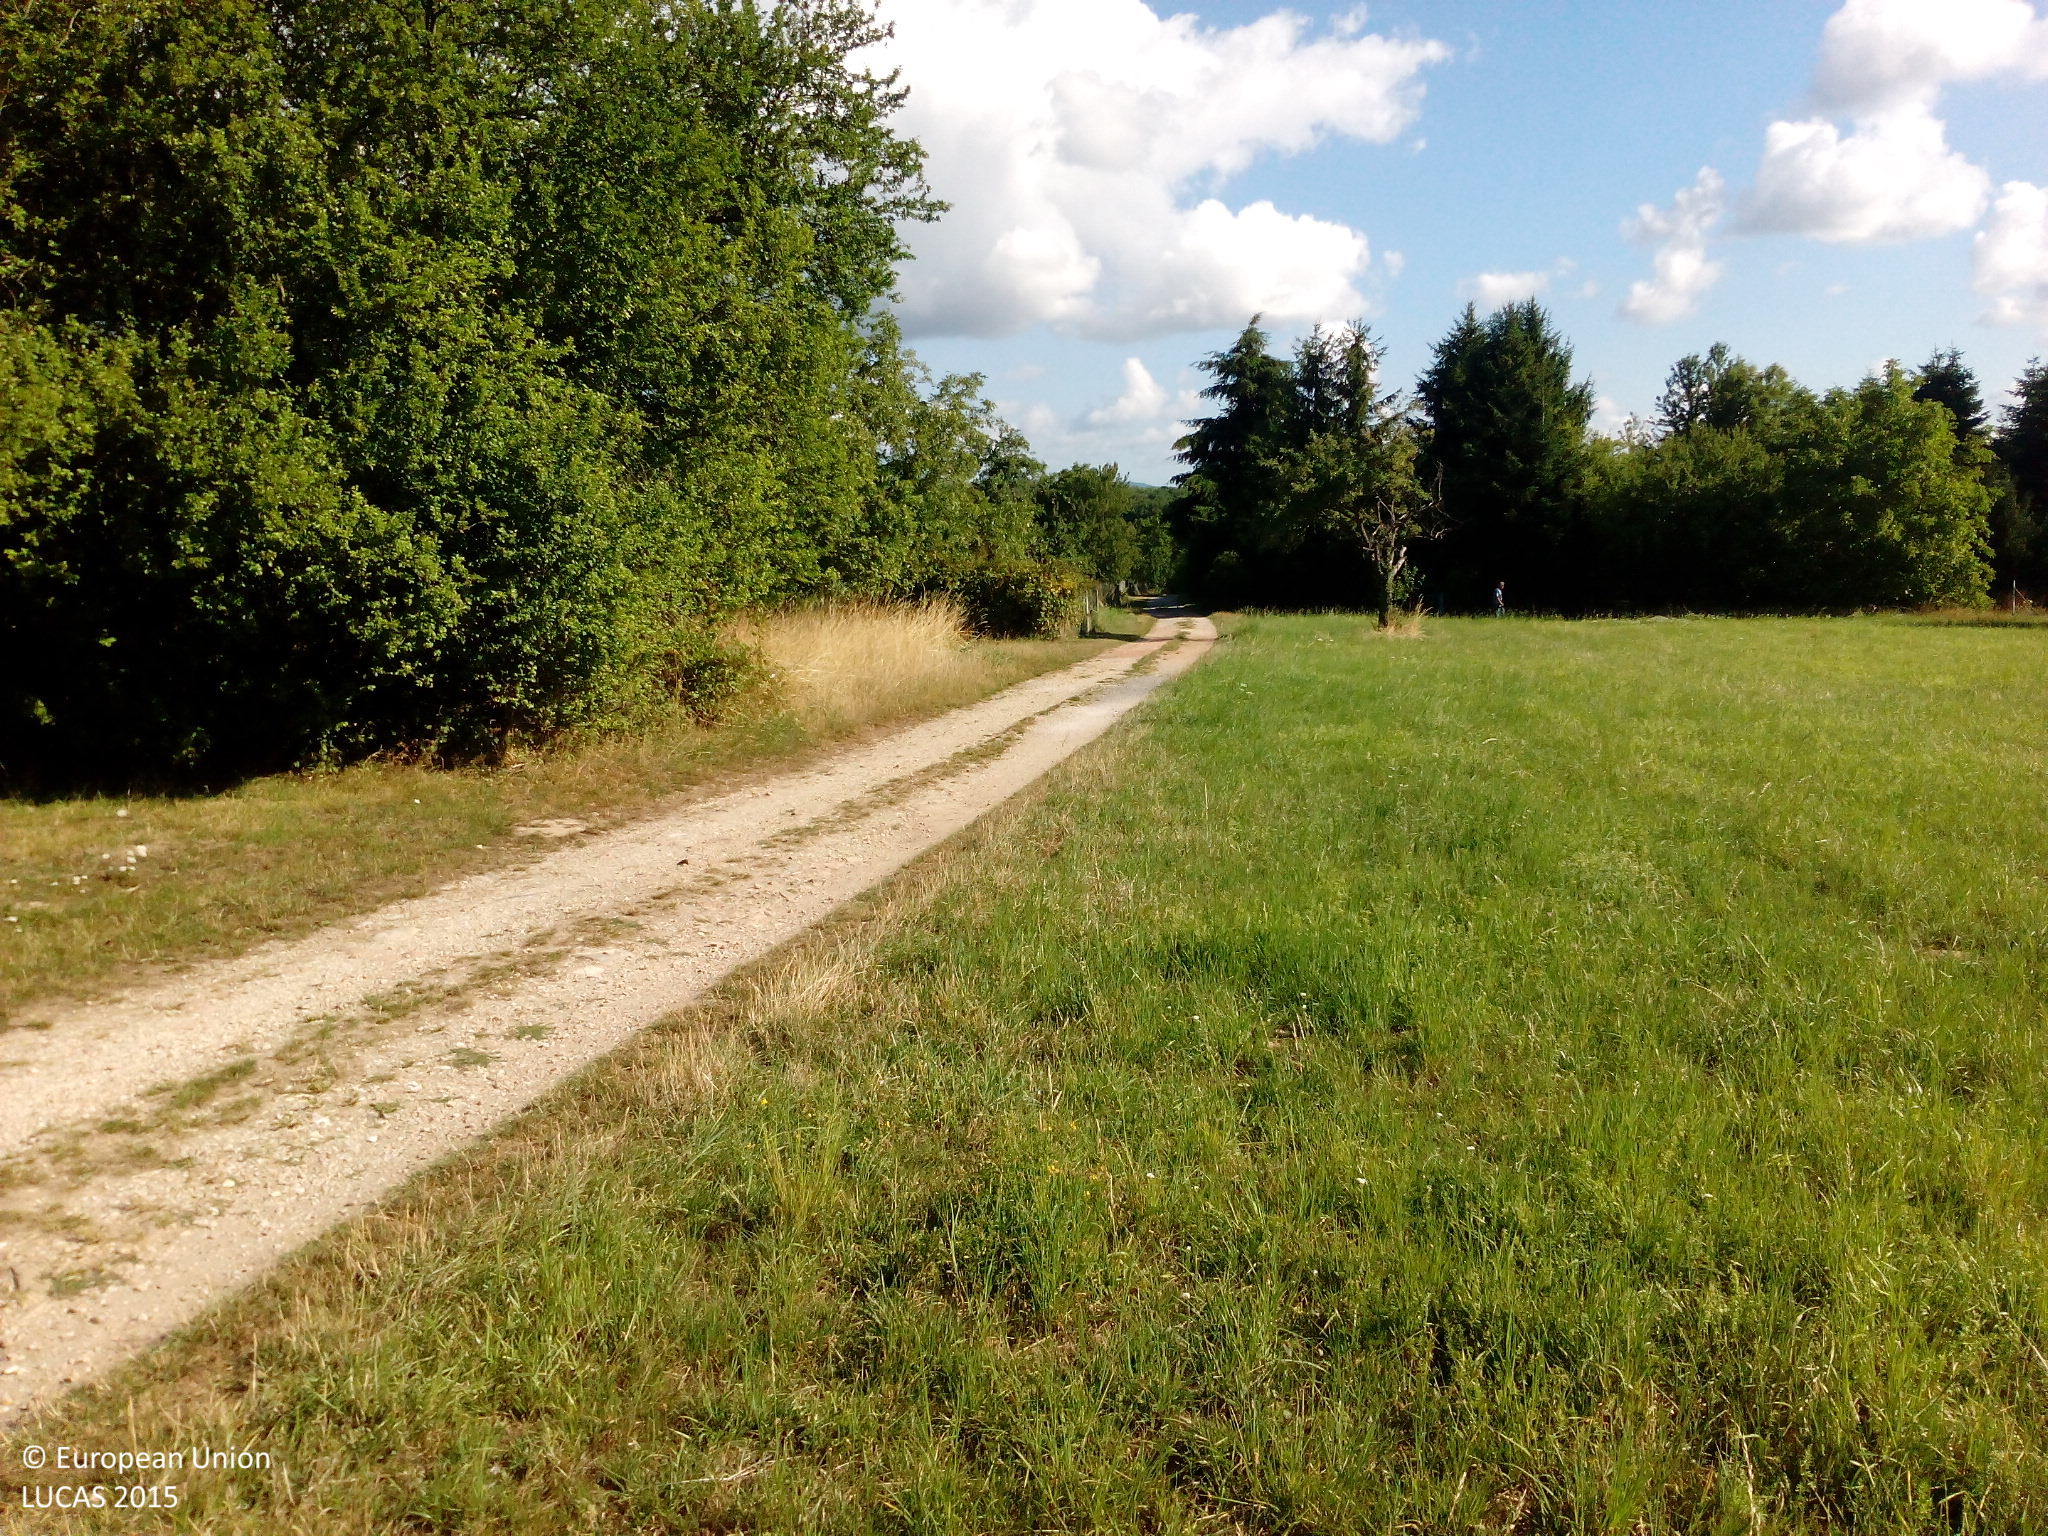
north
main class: Grassland
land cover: Grassland without tree/shrub cover
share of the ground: > 75 %
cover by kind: herbaceous plants 90 %, unconsolidated bare surface 10 %
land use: Agriculture (excluding fallow land and kitchen gardens)
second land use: Amenities, museums, leisure
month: July
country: DE
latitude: 50.1017
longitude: 8.4485
